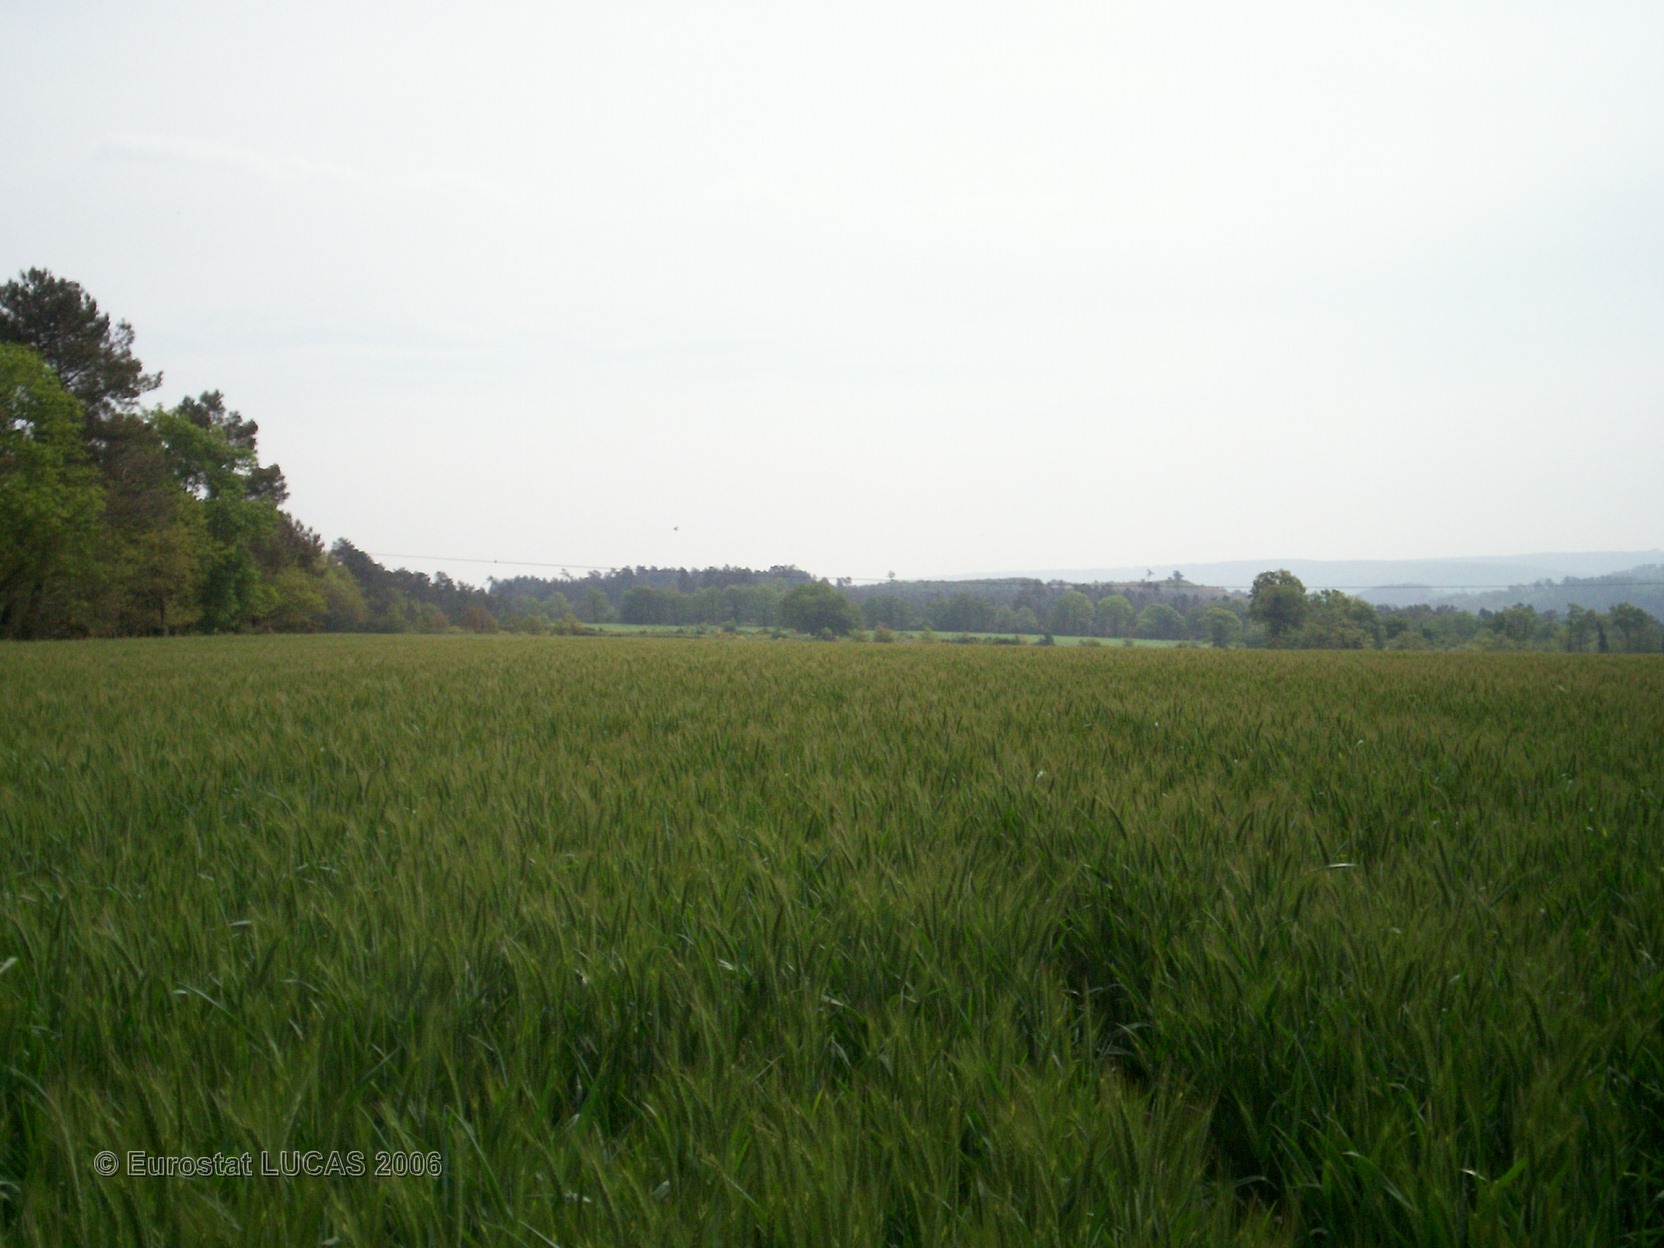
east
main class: Cropland
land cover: Common wheat
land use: Agriculture (excluding fallow land and kitchen gardens)
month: May
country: FR
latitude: 47.7987
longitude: -2.3525
